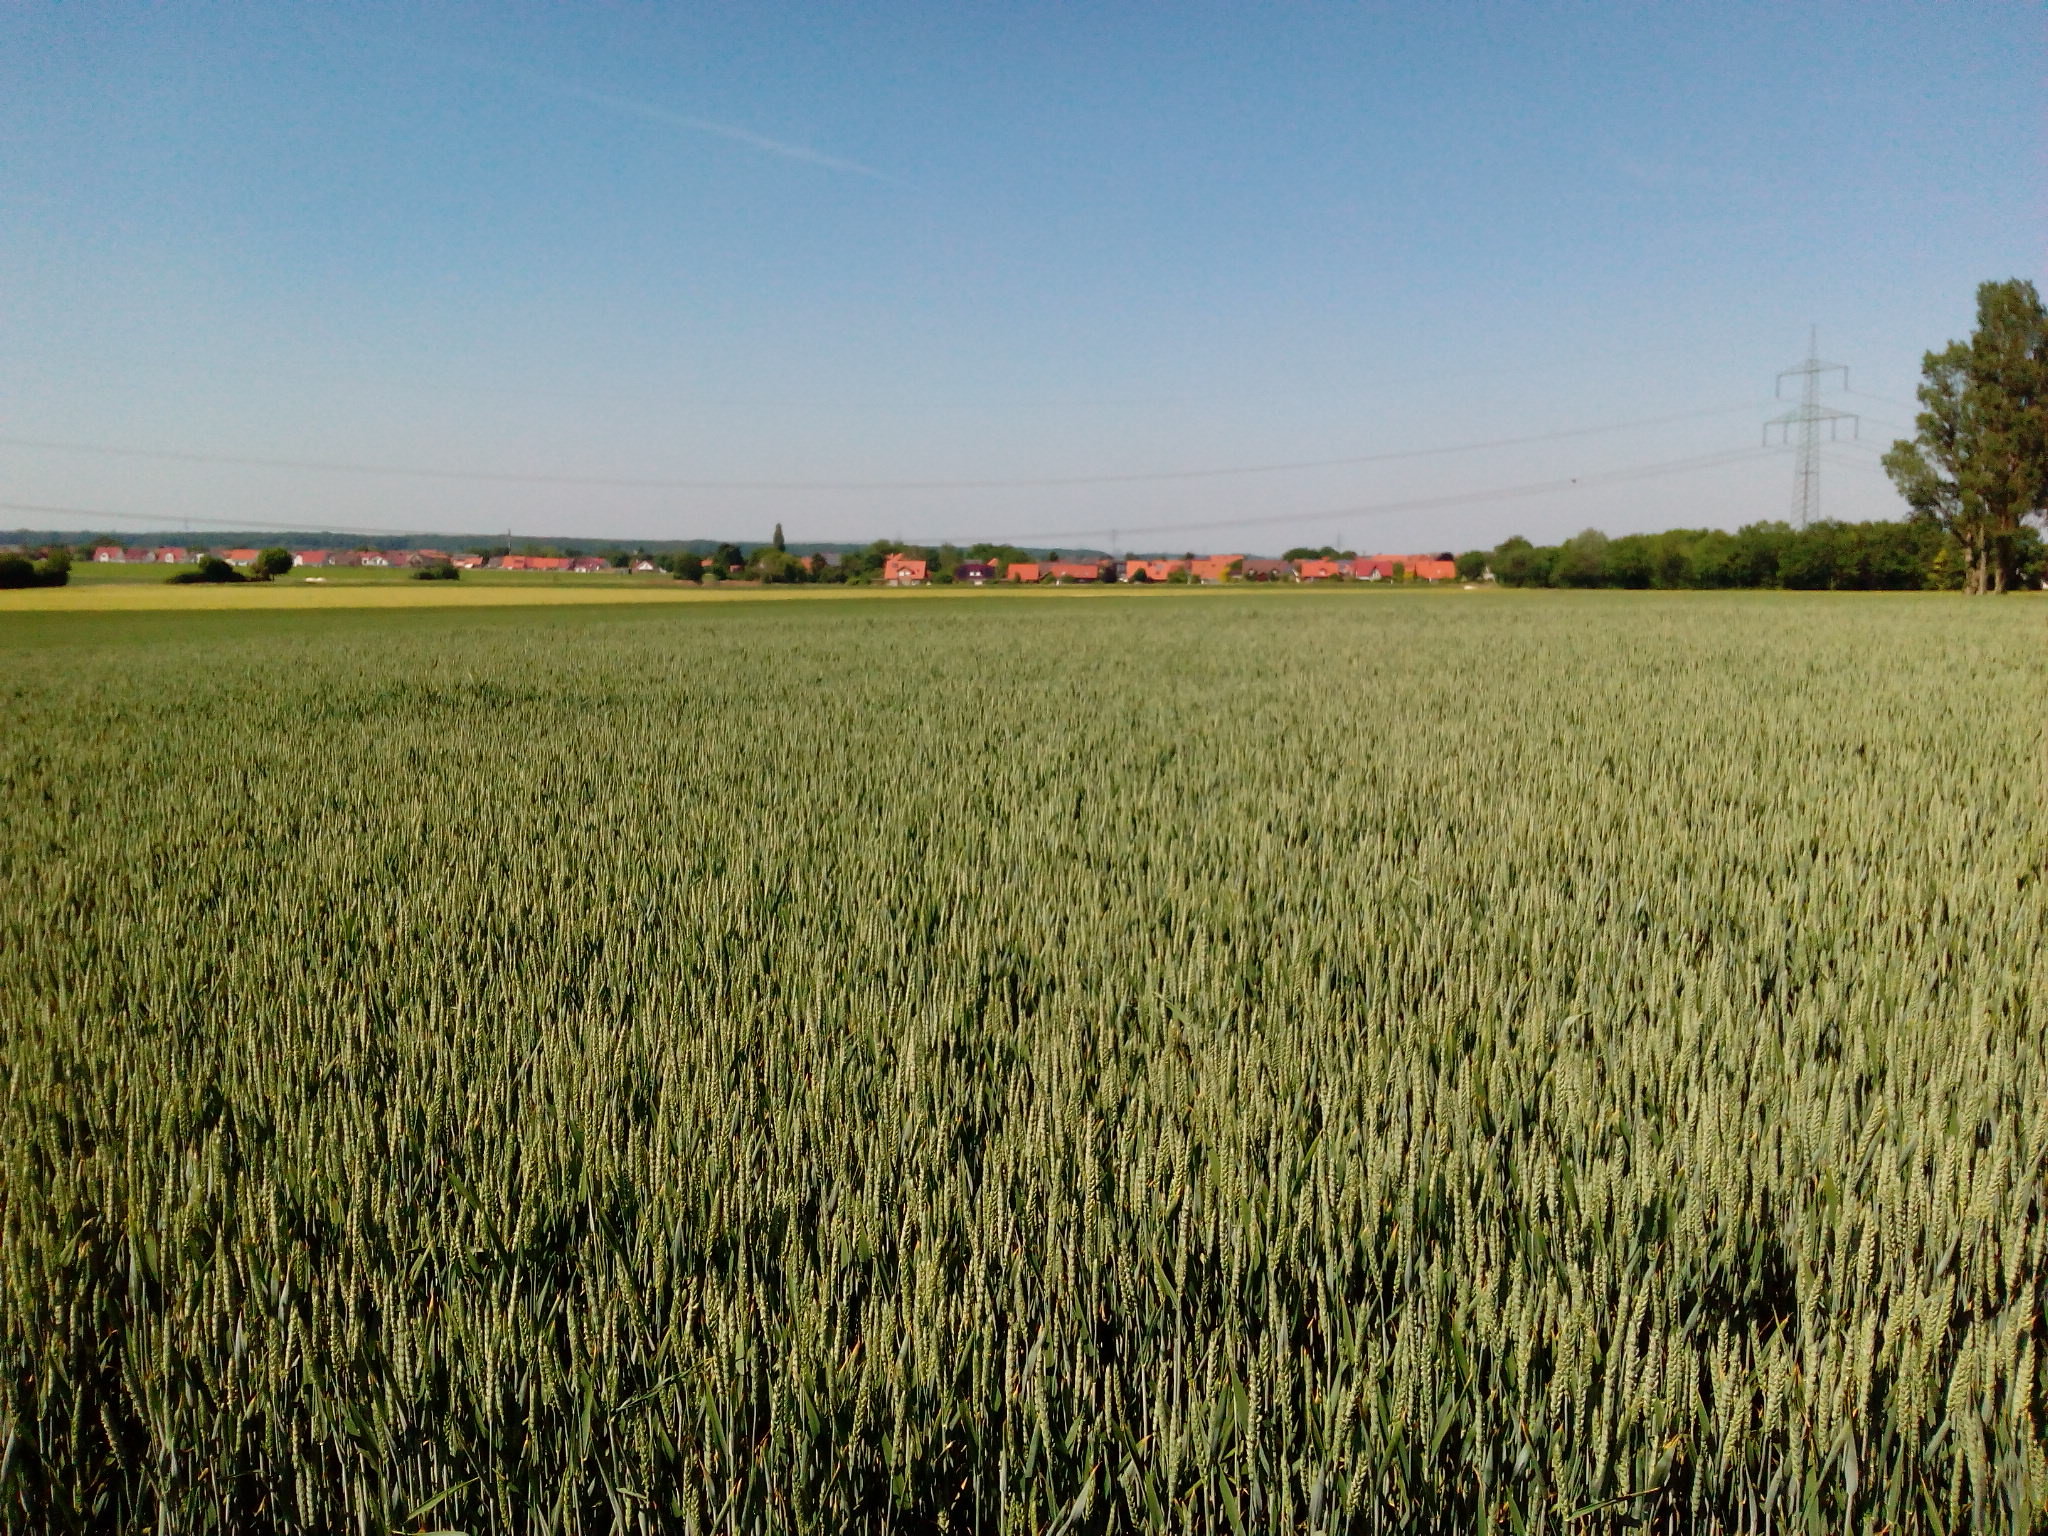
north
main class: Cropland
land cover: Common wheat
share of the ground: > 75 %
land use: Agriculture (excluding fallow land and kitchen gardens)
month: June
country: DE
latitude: 52.2696
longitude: 9.8975
